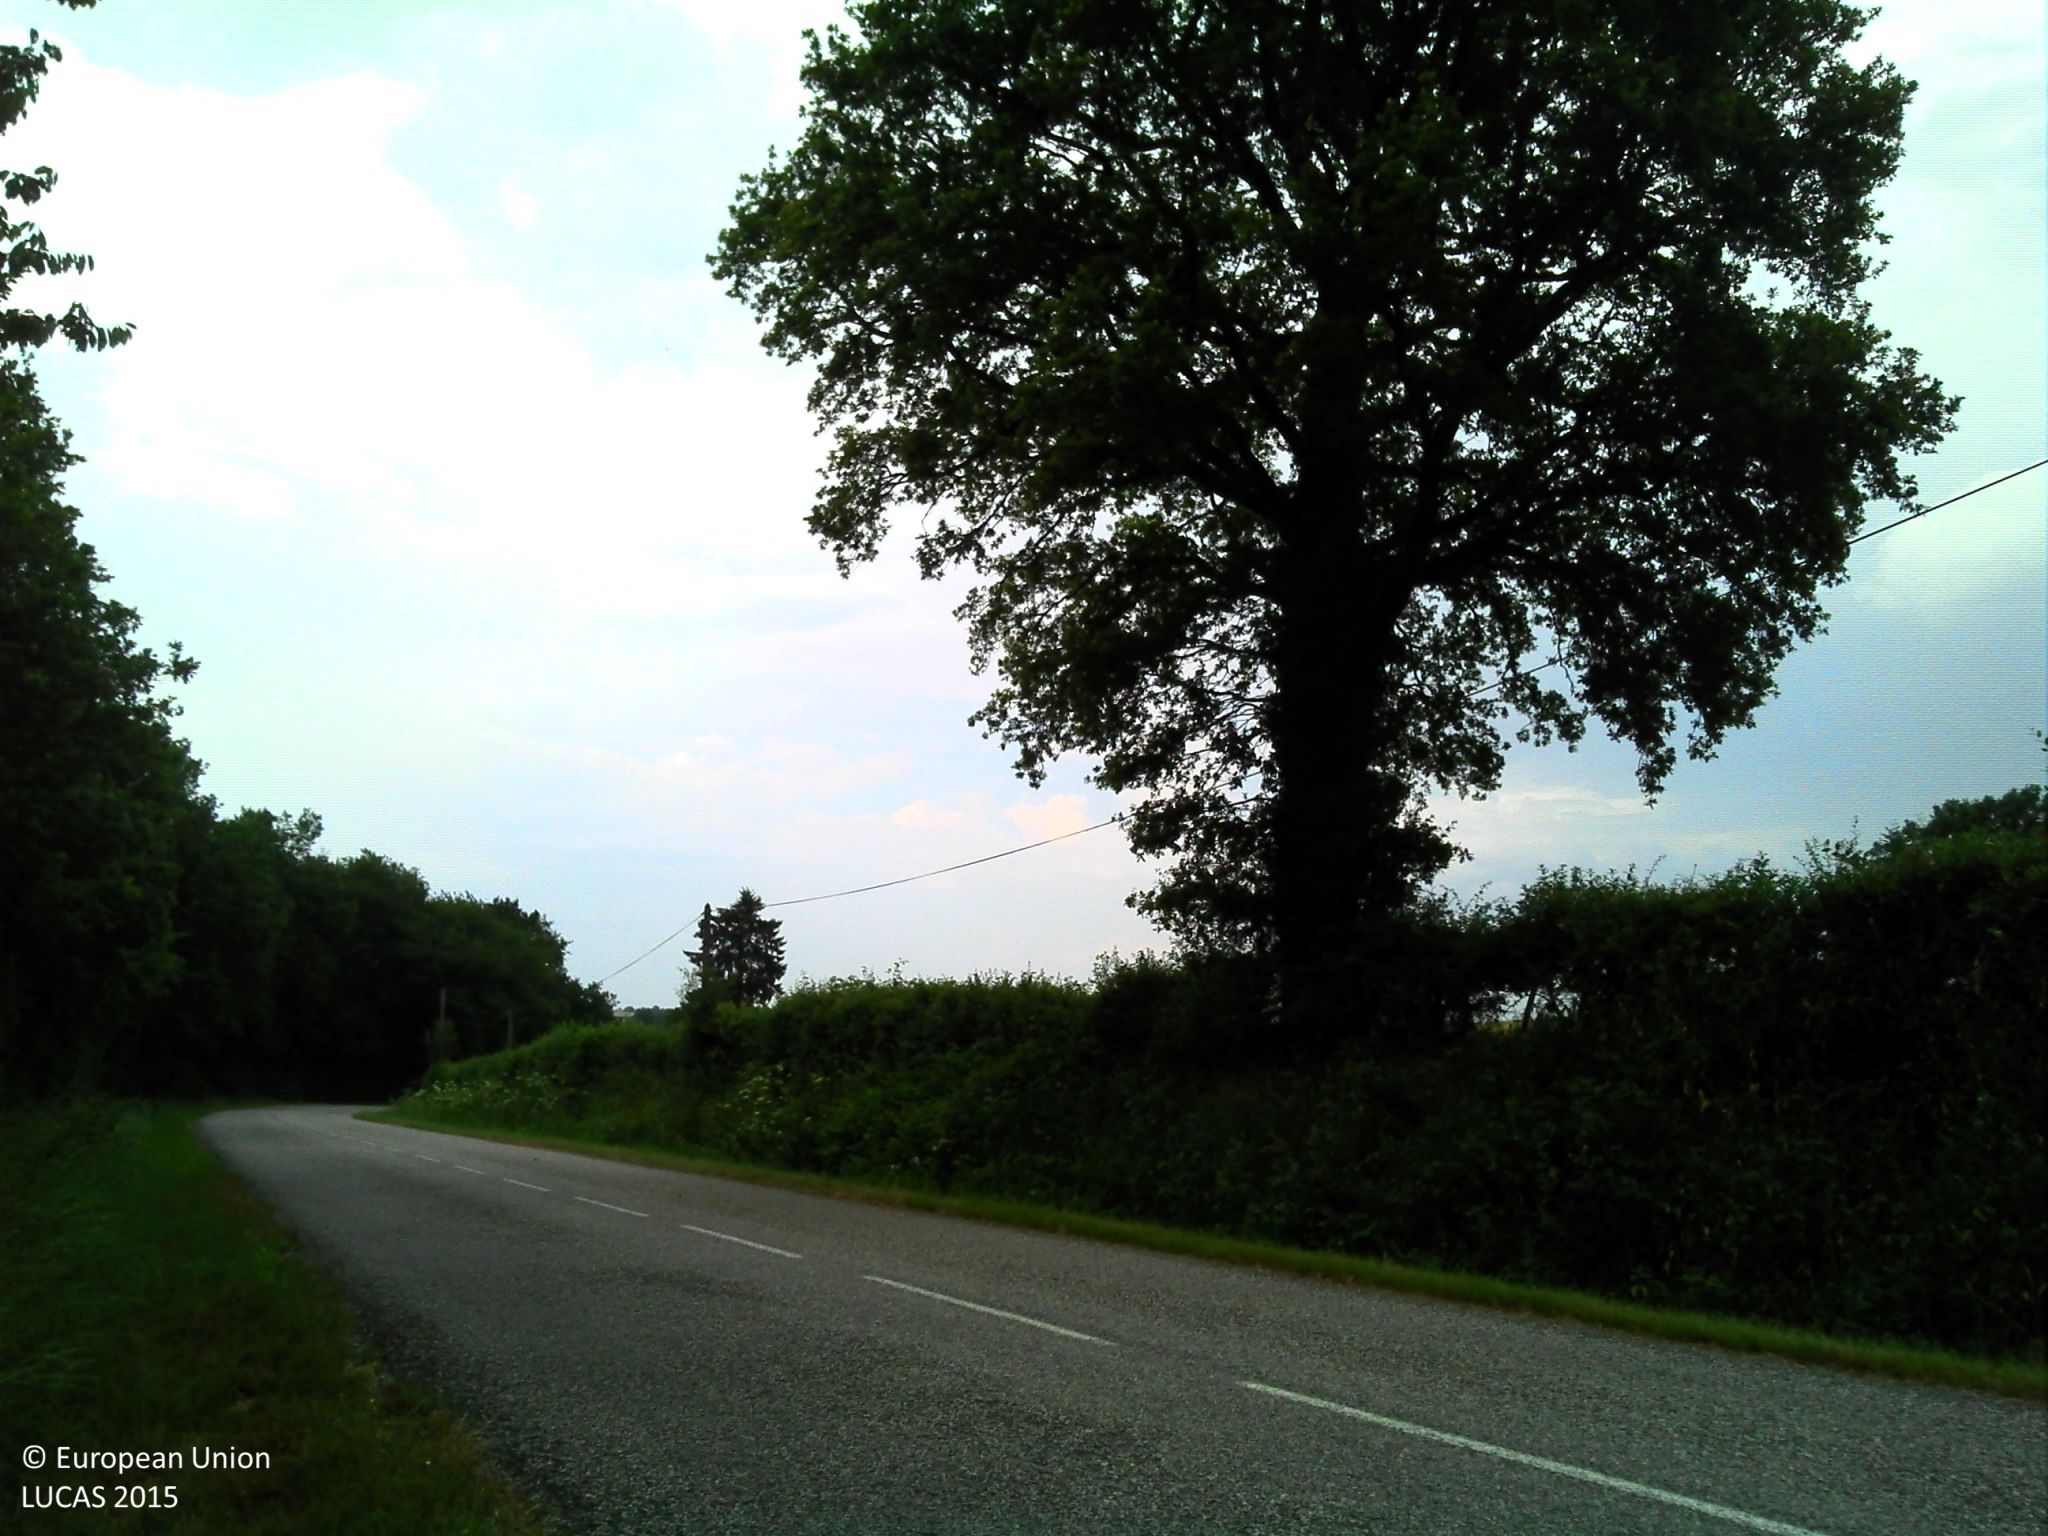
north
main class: Woodland
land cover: Broadleaved woodland
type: mesophytic deciduous forest
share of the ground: > 75 %
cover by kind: broadleaved forest trees 90 %, shrubs 5 %, herbaceous plants 5 %
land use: Forestry
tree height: > 5 m
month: June
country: FR
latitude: 46.3042
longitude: 3.0256
